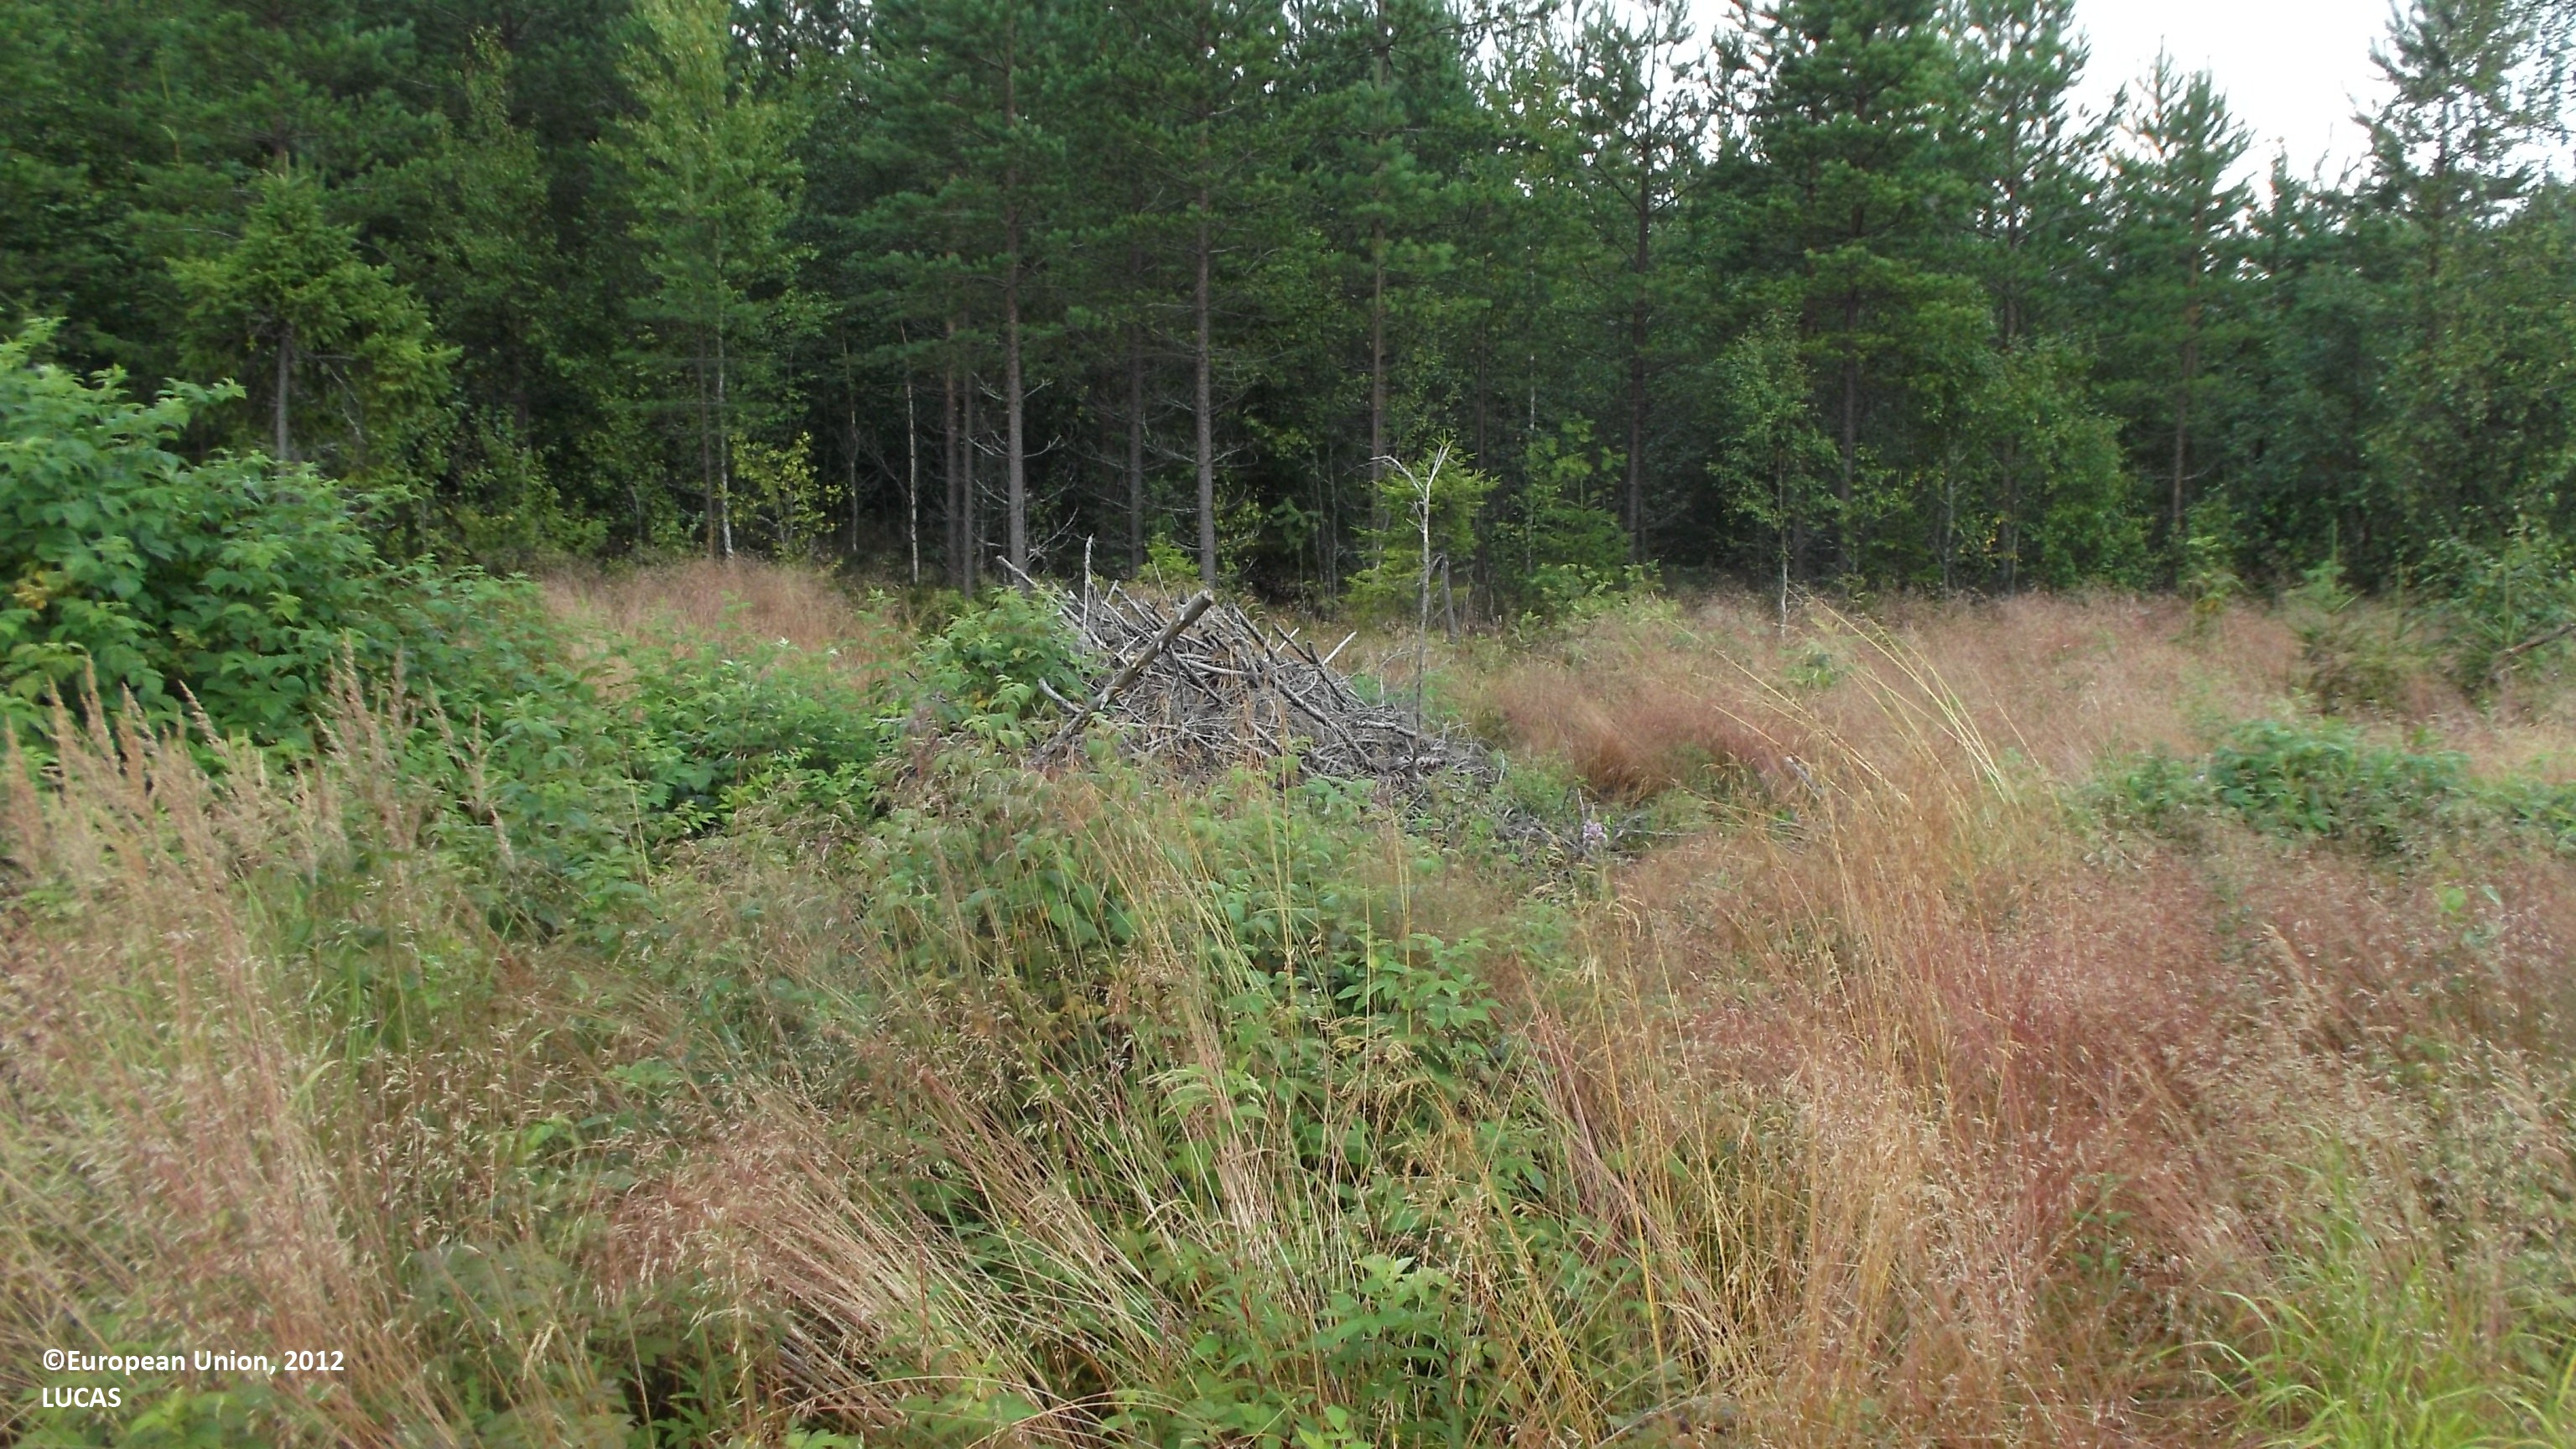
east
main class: Grassland
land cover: Grassland without tree/shrub cover
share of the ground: 50 - 75 %
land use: Forestry
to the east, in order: Grassland without tree/shrub cover; Pine dominated mixed woodland; Other mixed woodland; Spontaneously vegetated surfaces; Other mixed woodland; Pine dominated mixed woodland; Other mixed woodland
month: August
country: FI
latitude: 63.8648
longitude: 23.3842
